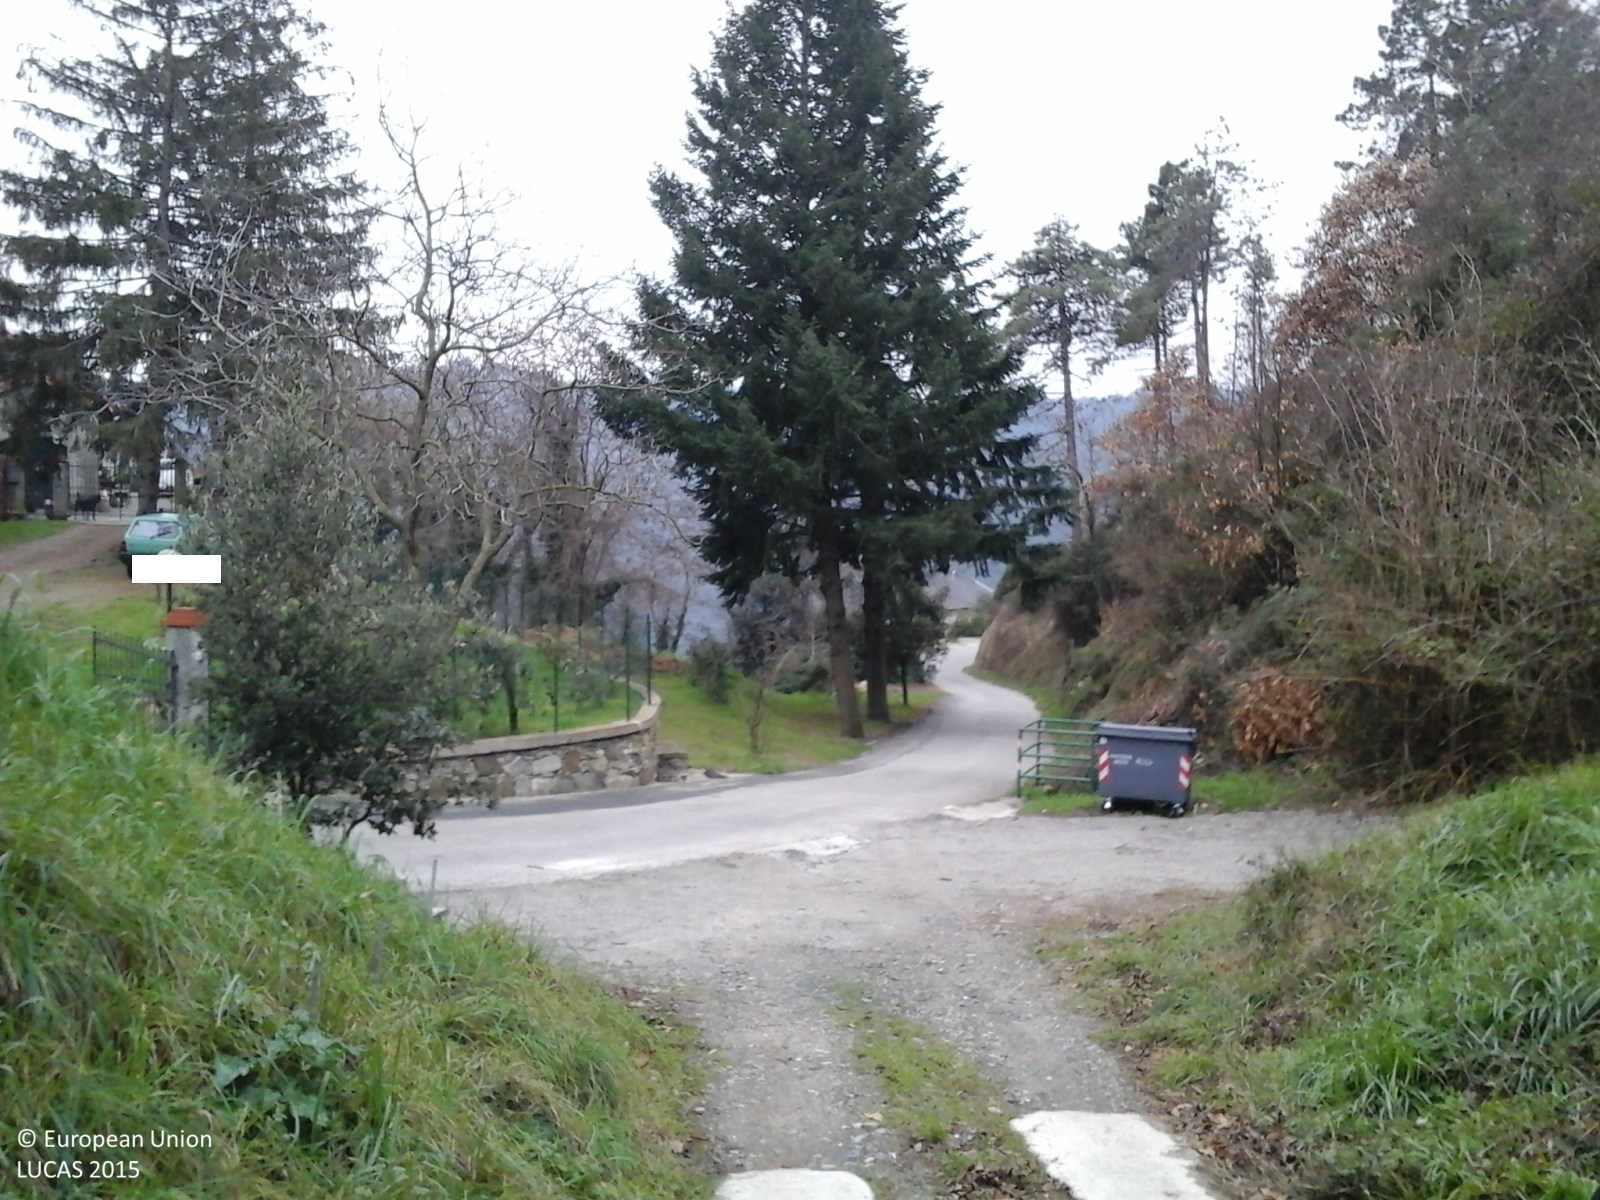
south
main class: Woodland
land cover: Pine dominated coniferous woodland
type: coniferous forest of the mediterranean region
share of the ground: > 75 %
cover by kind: coniferous forest trees 80 %, broadleaved forest trees 10 %, shrubs 10 %
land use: Forestry
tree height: > 5 m
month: October
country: IT
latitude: 44.2773
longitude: 9.5125
